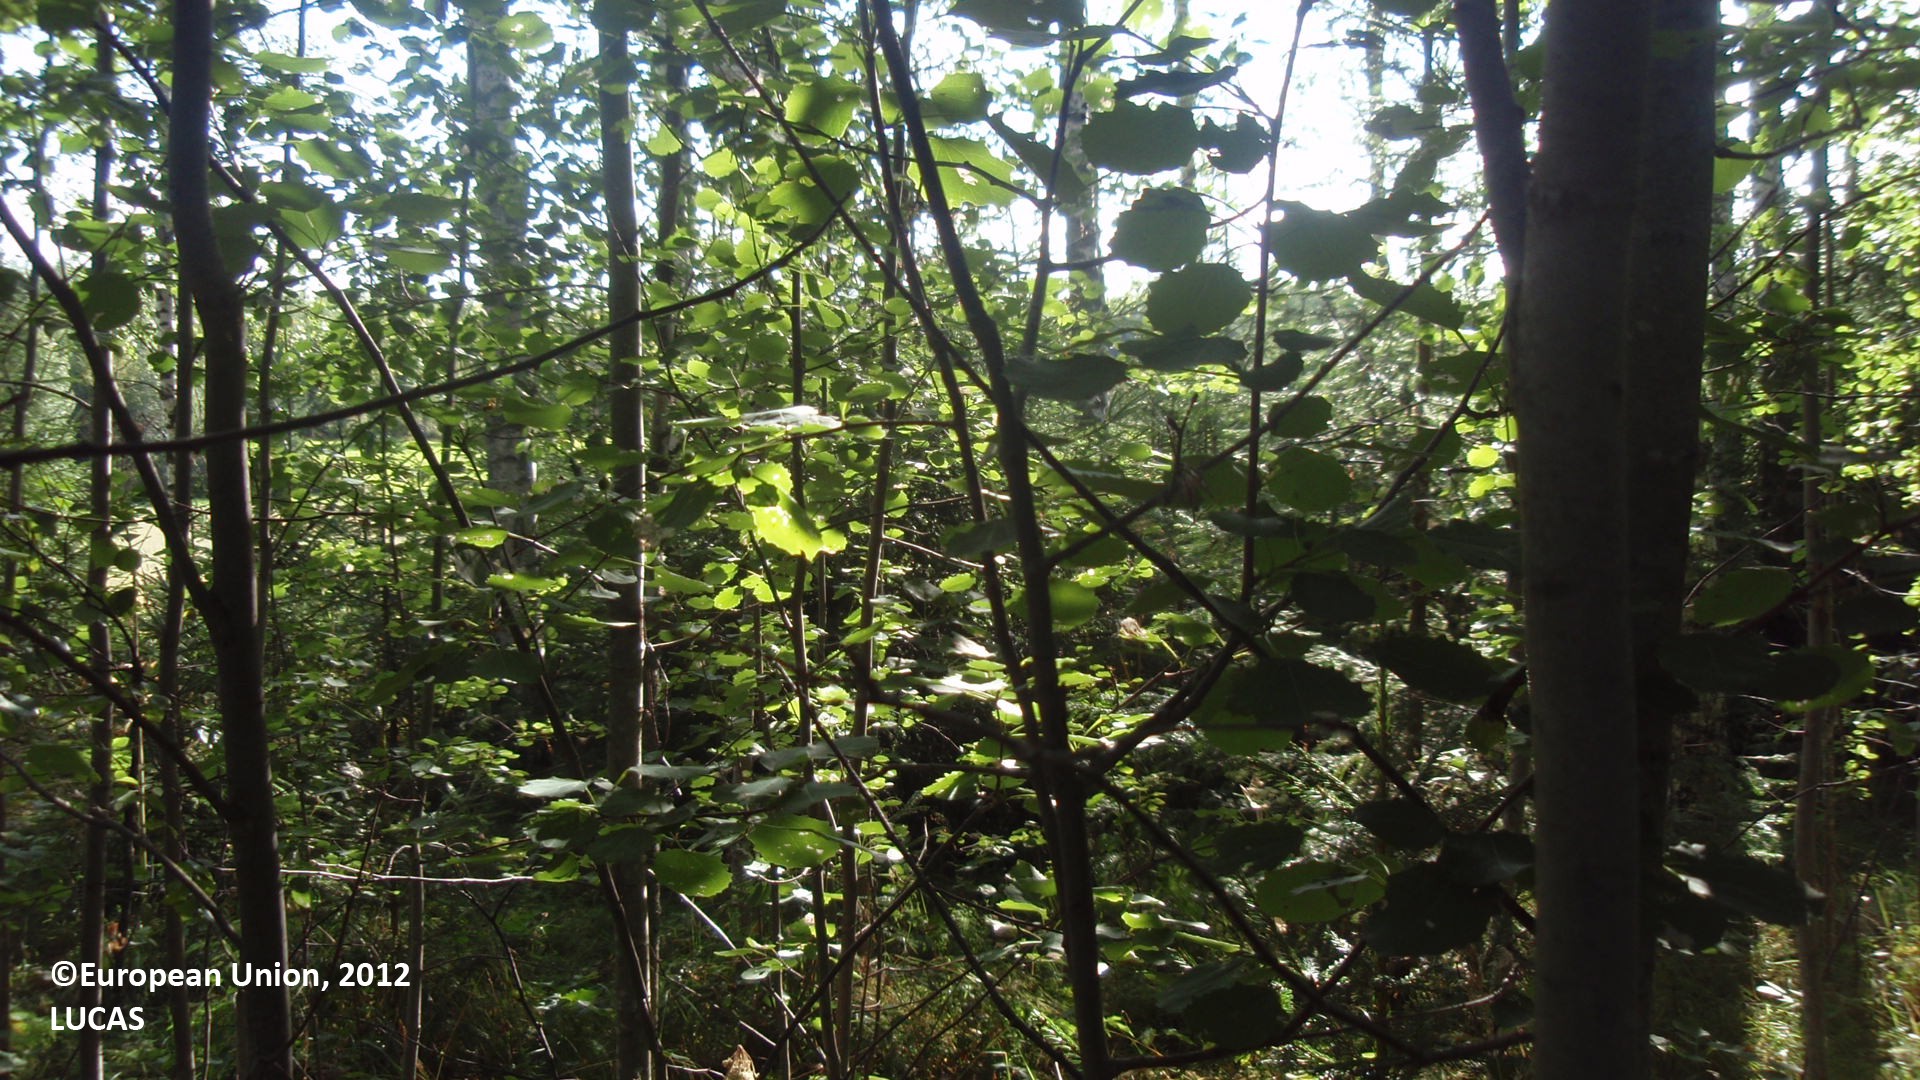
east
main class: Woodland
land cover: Broadleaved woodland
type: non-riverine alder, birch or aspen forest
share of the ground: 50 - 75 %
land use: Forestry
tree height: > 5 m
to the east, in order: Broadleaved woodland; Grass margins; Paved roads, cycling and walking lanes; Grass margins; Oats; Ditches and canals; Grassland without tree/shrub cover
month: August
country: FI
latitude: 60.6162
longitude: 27.1481
